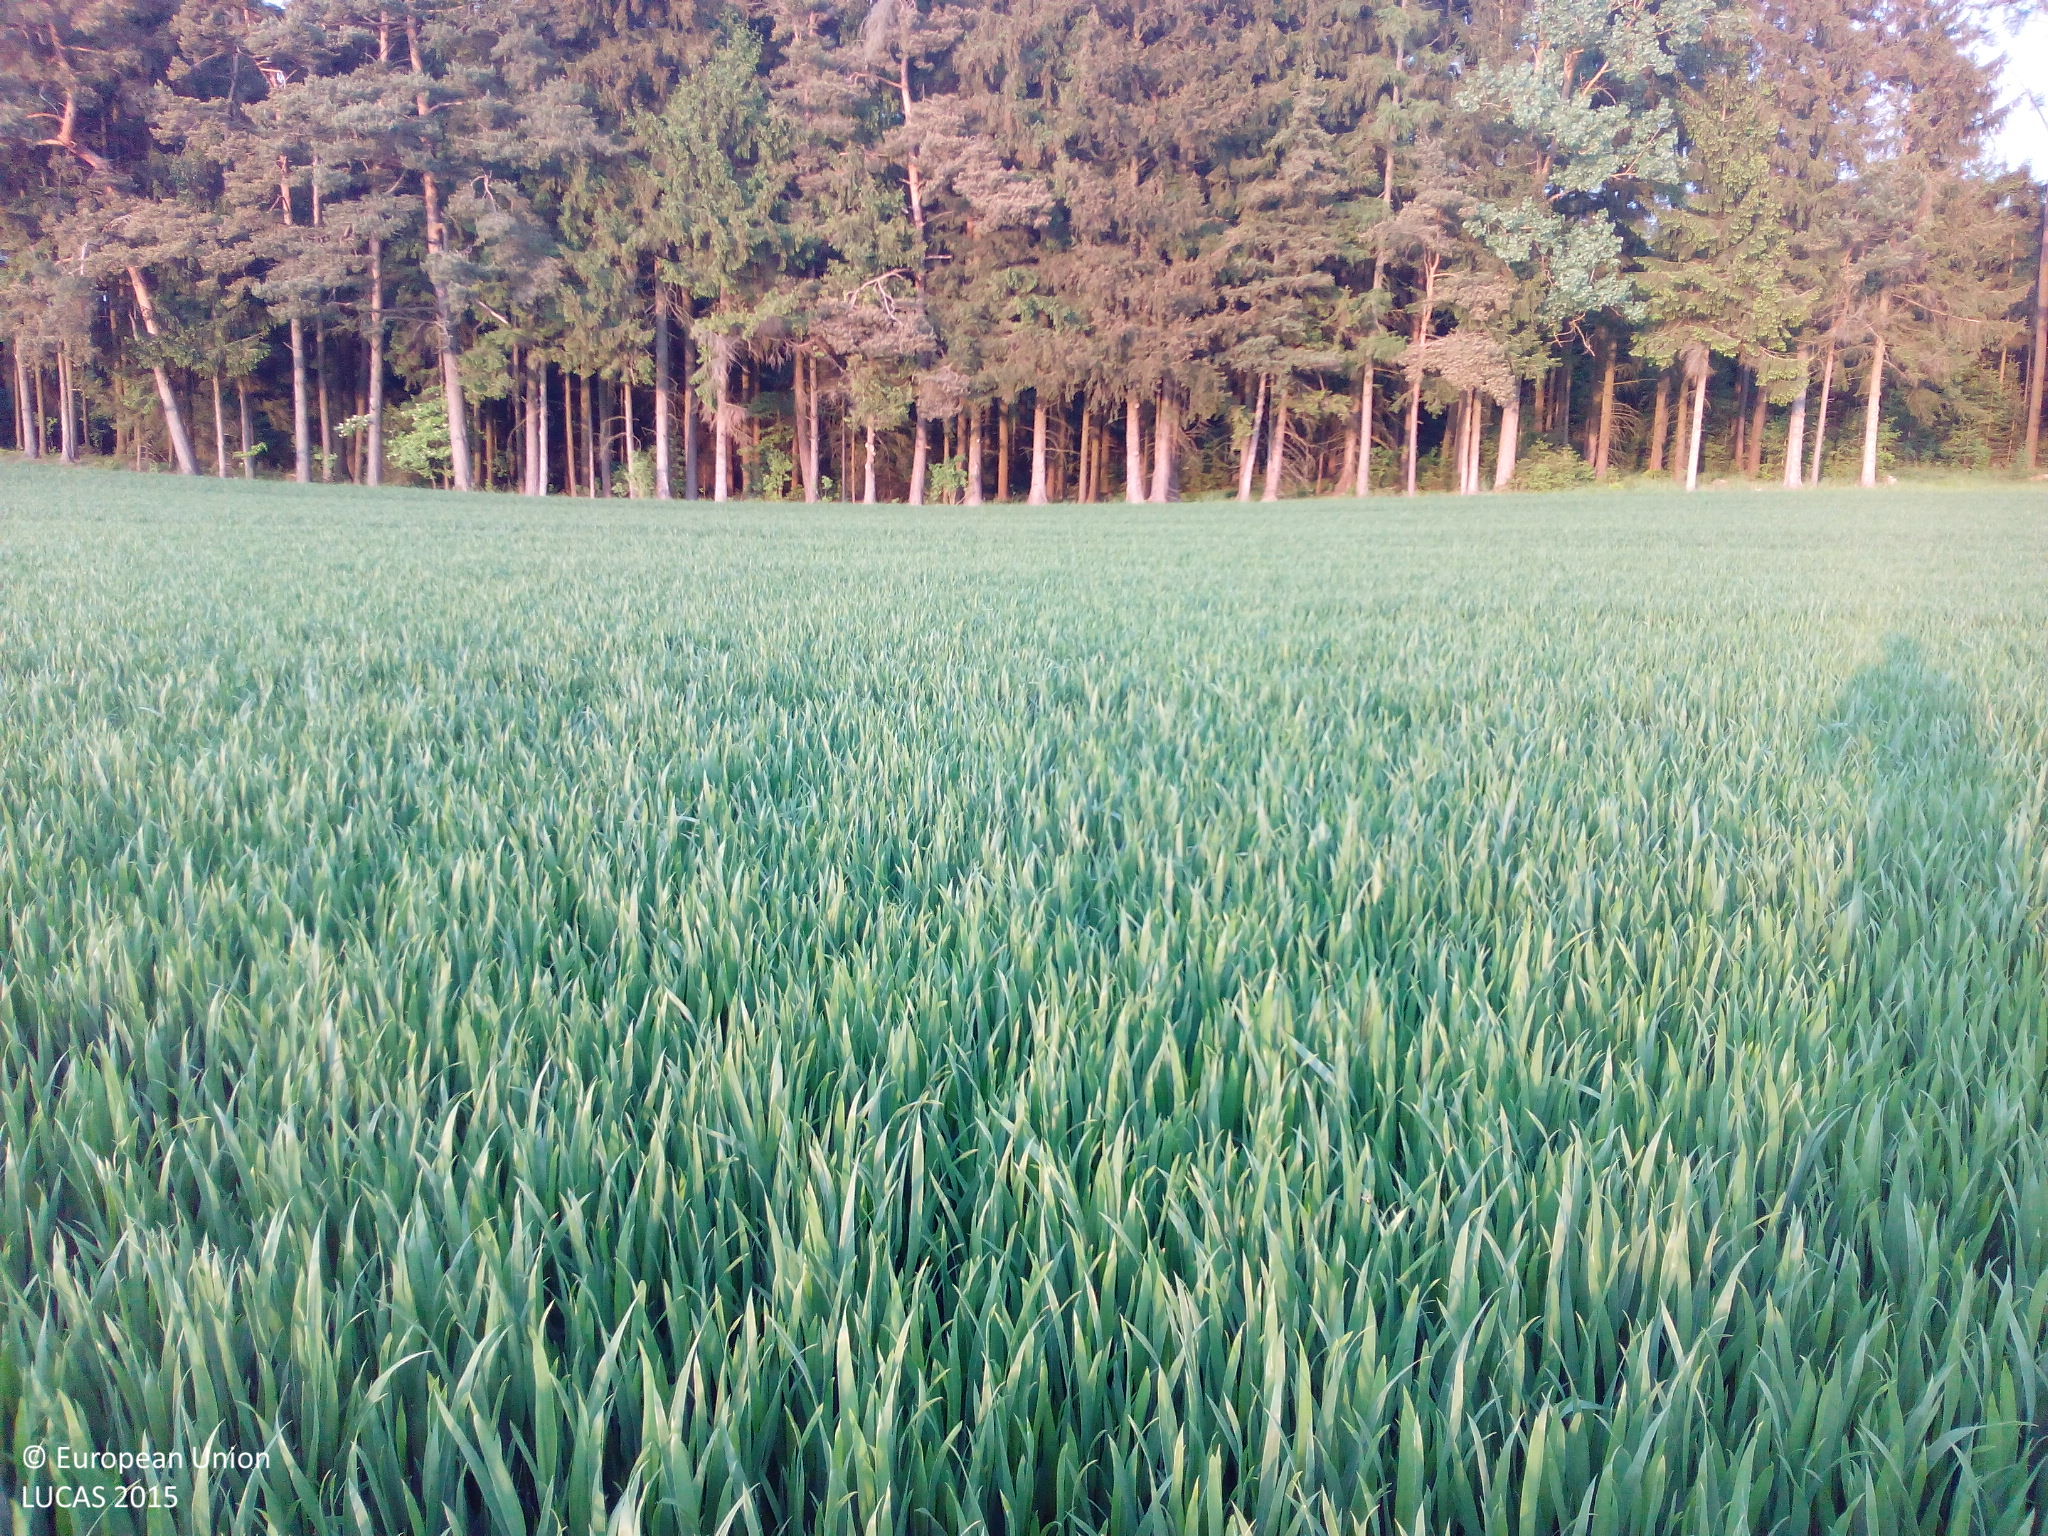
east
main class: Cropland
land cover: Common wheat
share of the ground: > 75 %
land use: Agriculture (excluding fallow land and kitchen gardens)
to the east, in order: Common wheat; Grass margins; Tracks; Spruce dominated coniferous woodland; Grassland with sparse tree/shrub cover; Spruce dominated coniferous woodland
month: May
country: DE
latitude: 48.9693
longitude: 11.4884
